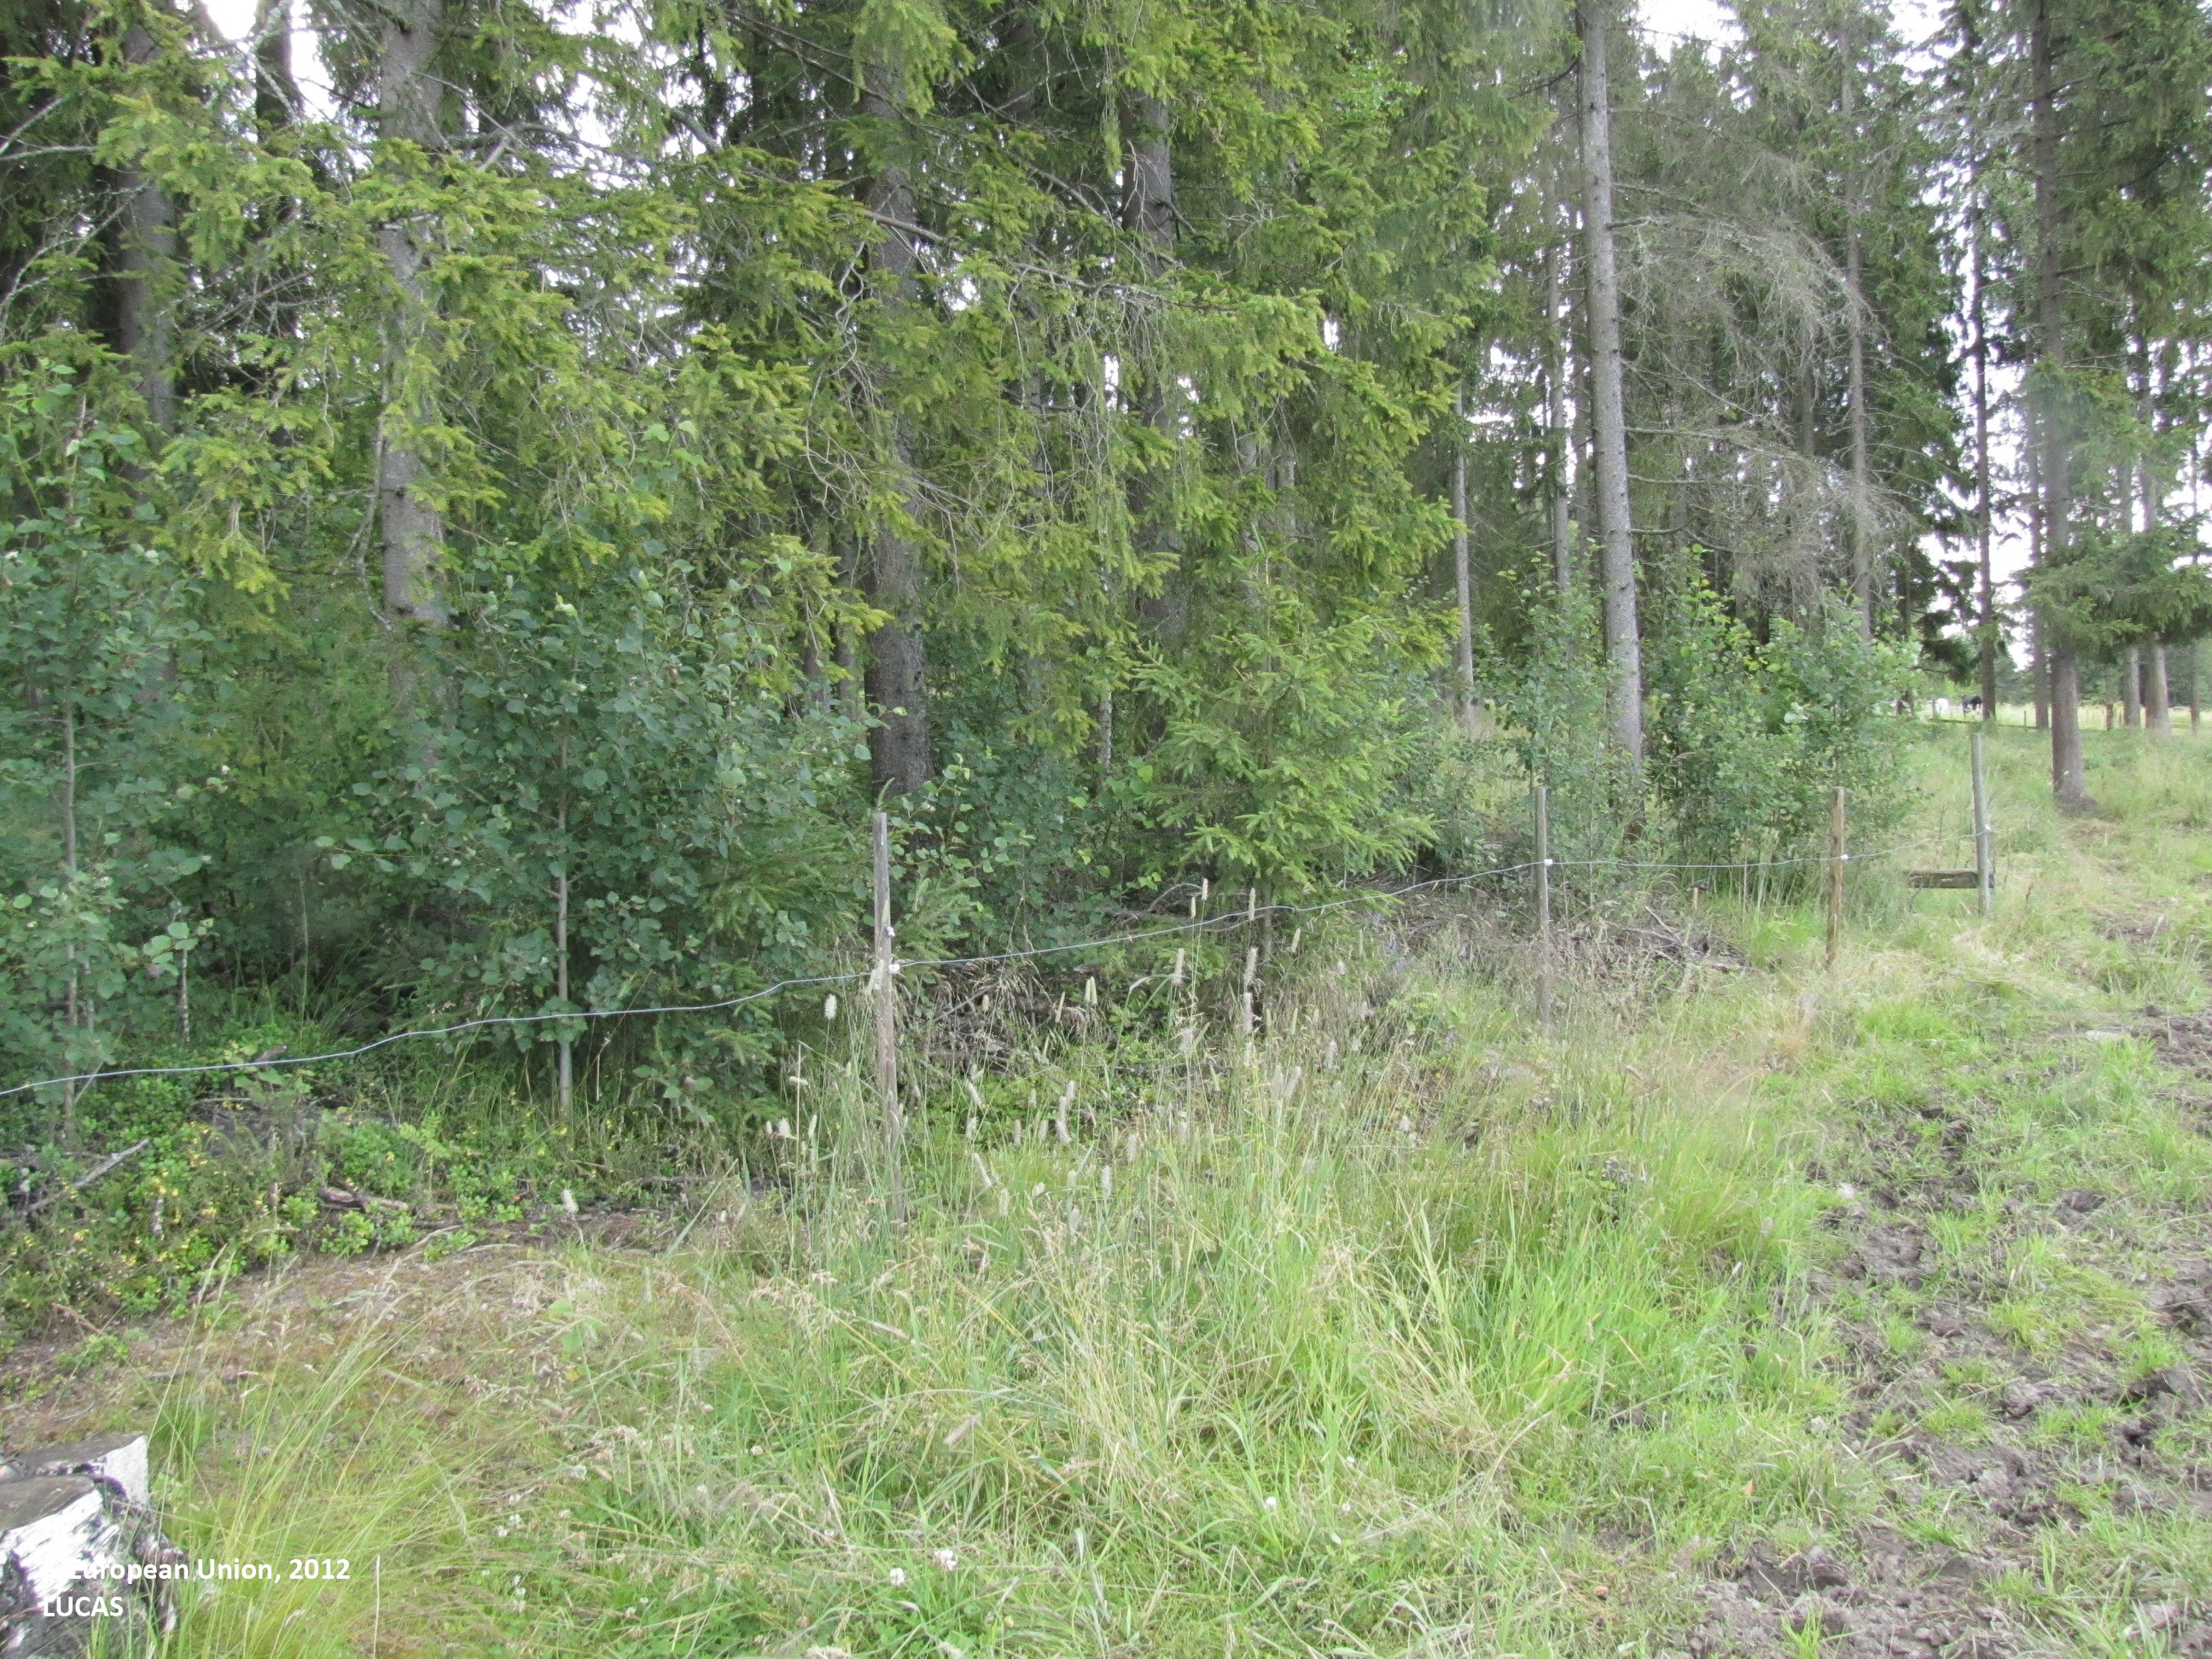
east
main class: Grassland
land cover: Grassland without tree/shrub cover
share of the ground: > 75 %
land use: Agriculture (excluding fallow land and kitchen gardens)
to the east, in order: Grassland without tree/shrub cover; Fences; Grassland without tree/shrub cover; Fences; Spruce dominated coniferous woodland; Ditches and canals; Grass margins; Tracks; Grass margins; Ditches and canals; Pine dominated coniferous woodland; Fences; Grassland without tree/shrub cover; Fences; Abandoned hedges; Ditches and canals; Grass margins; Tracks
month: July
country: FI
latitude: 62.6204
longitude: 23.3409
